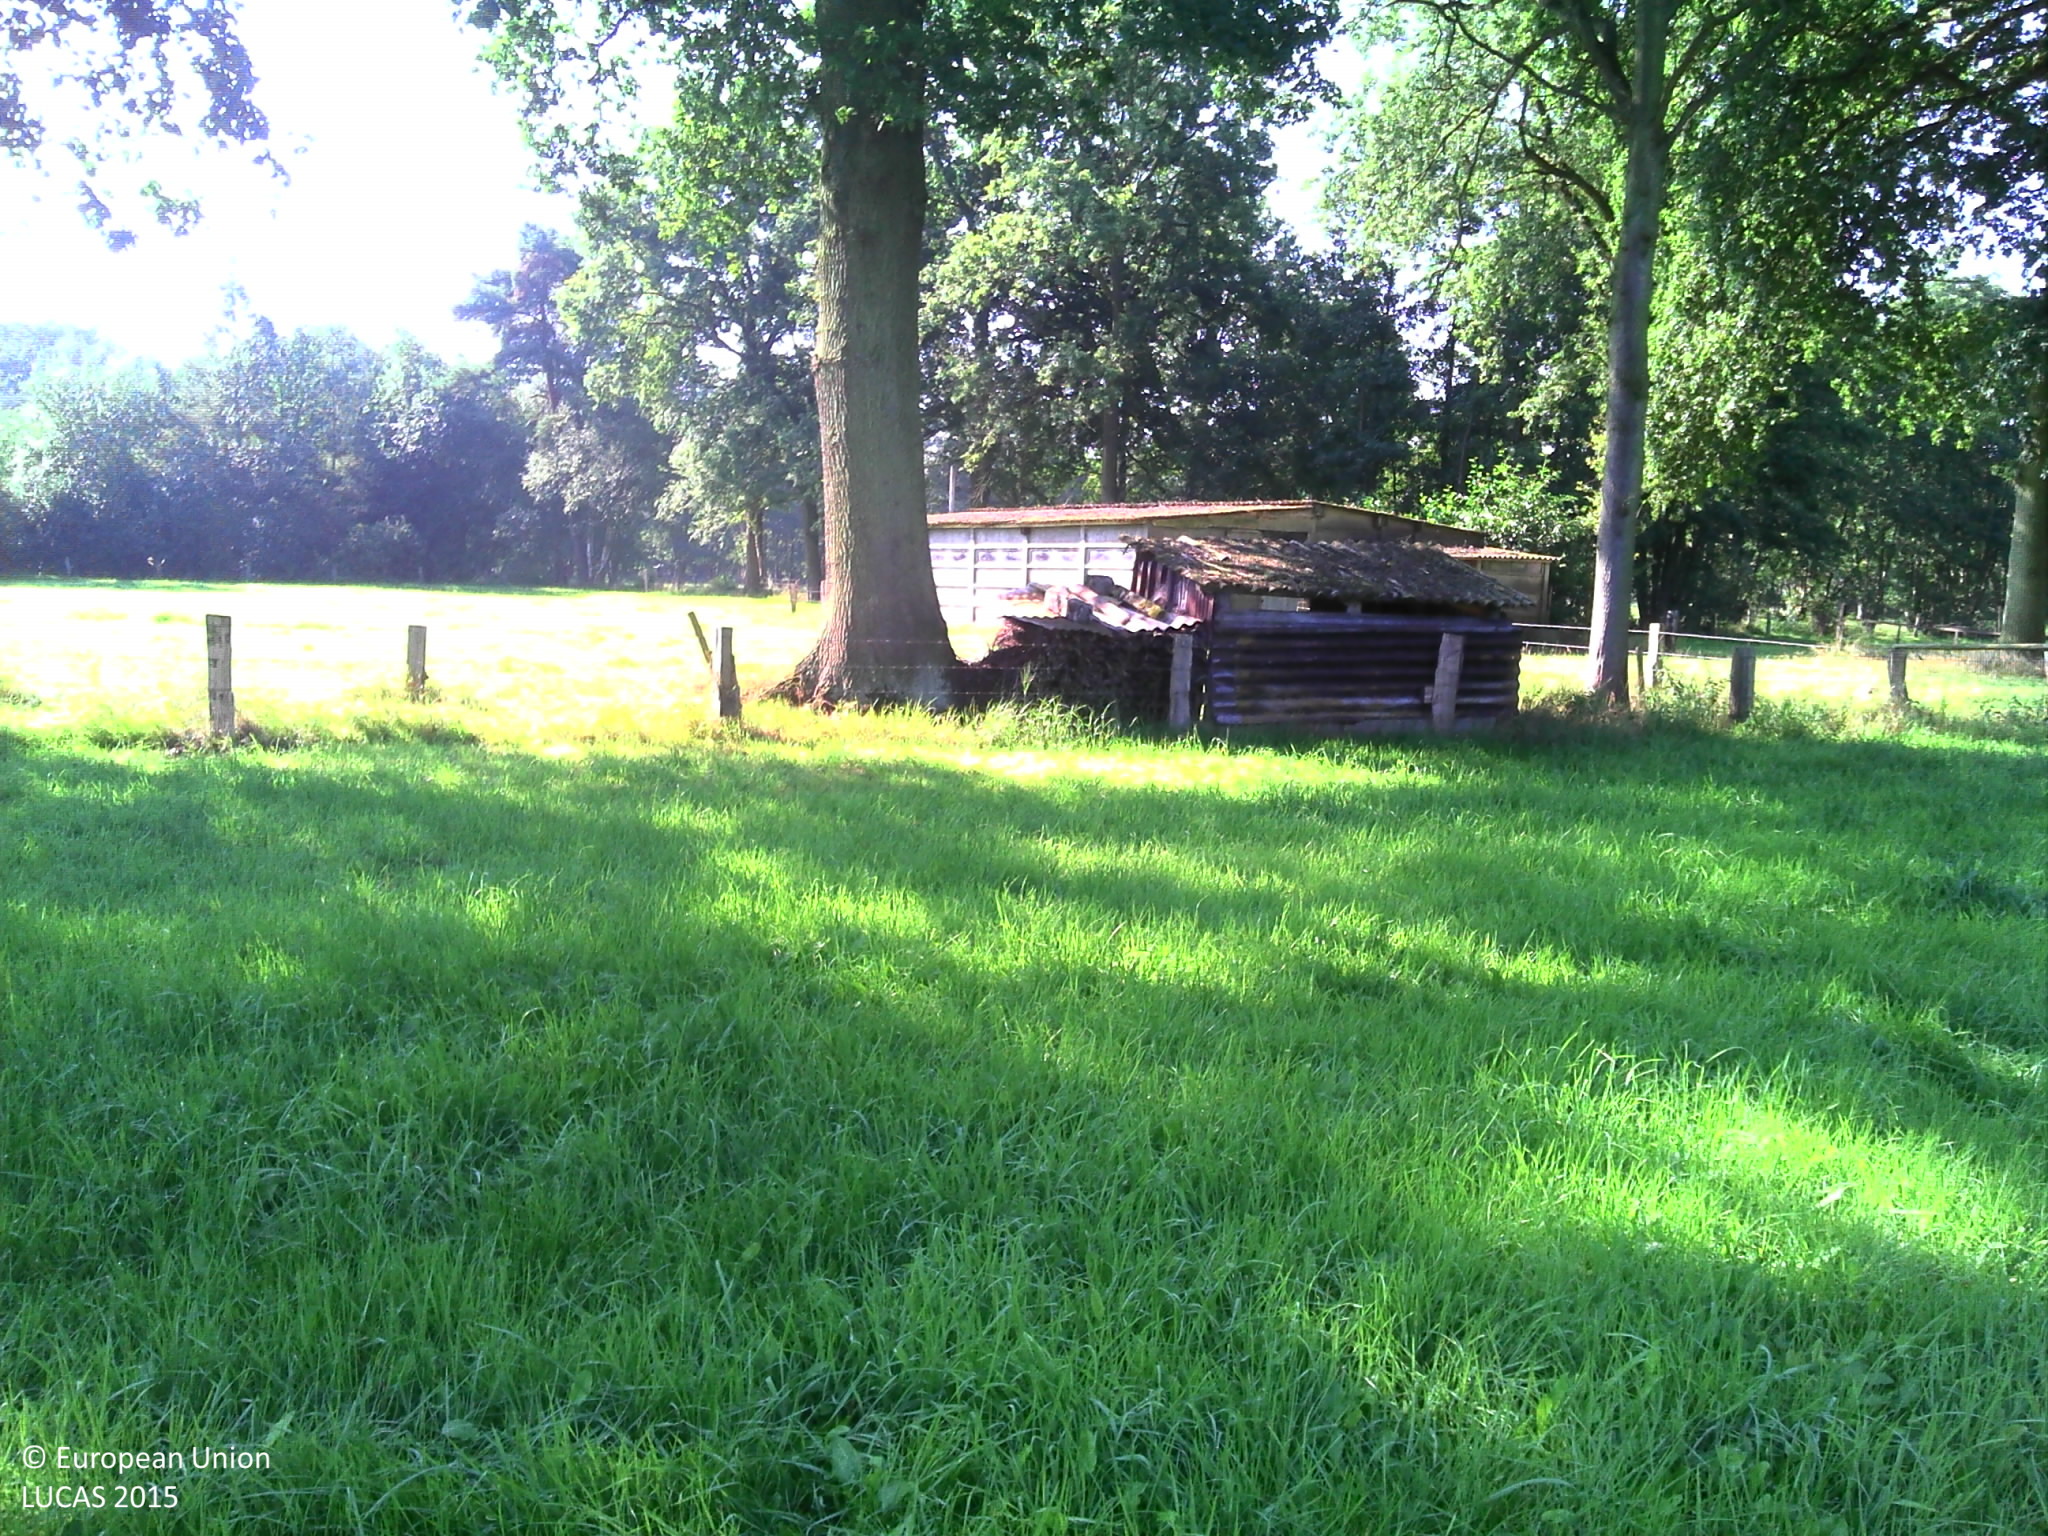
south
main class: Grassland
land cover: Grassland without tree/shrub cover
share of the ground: > 75 %
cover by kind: herbaceous plants 100 %
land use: Agriculture (excluding fallow land and kitchen gardens)
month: August
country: BE
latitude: 51.1654
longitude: 5.2355
